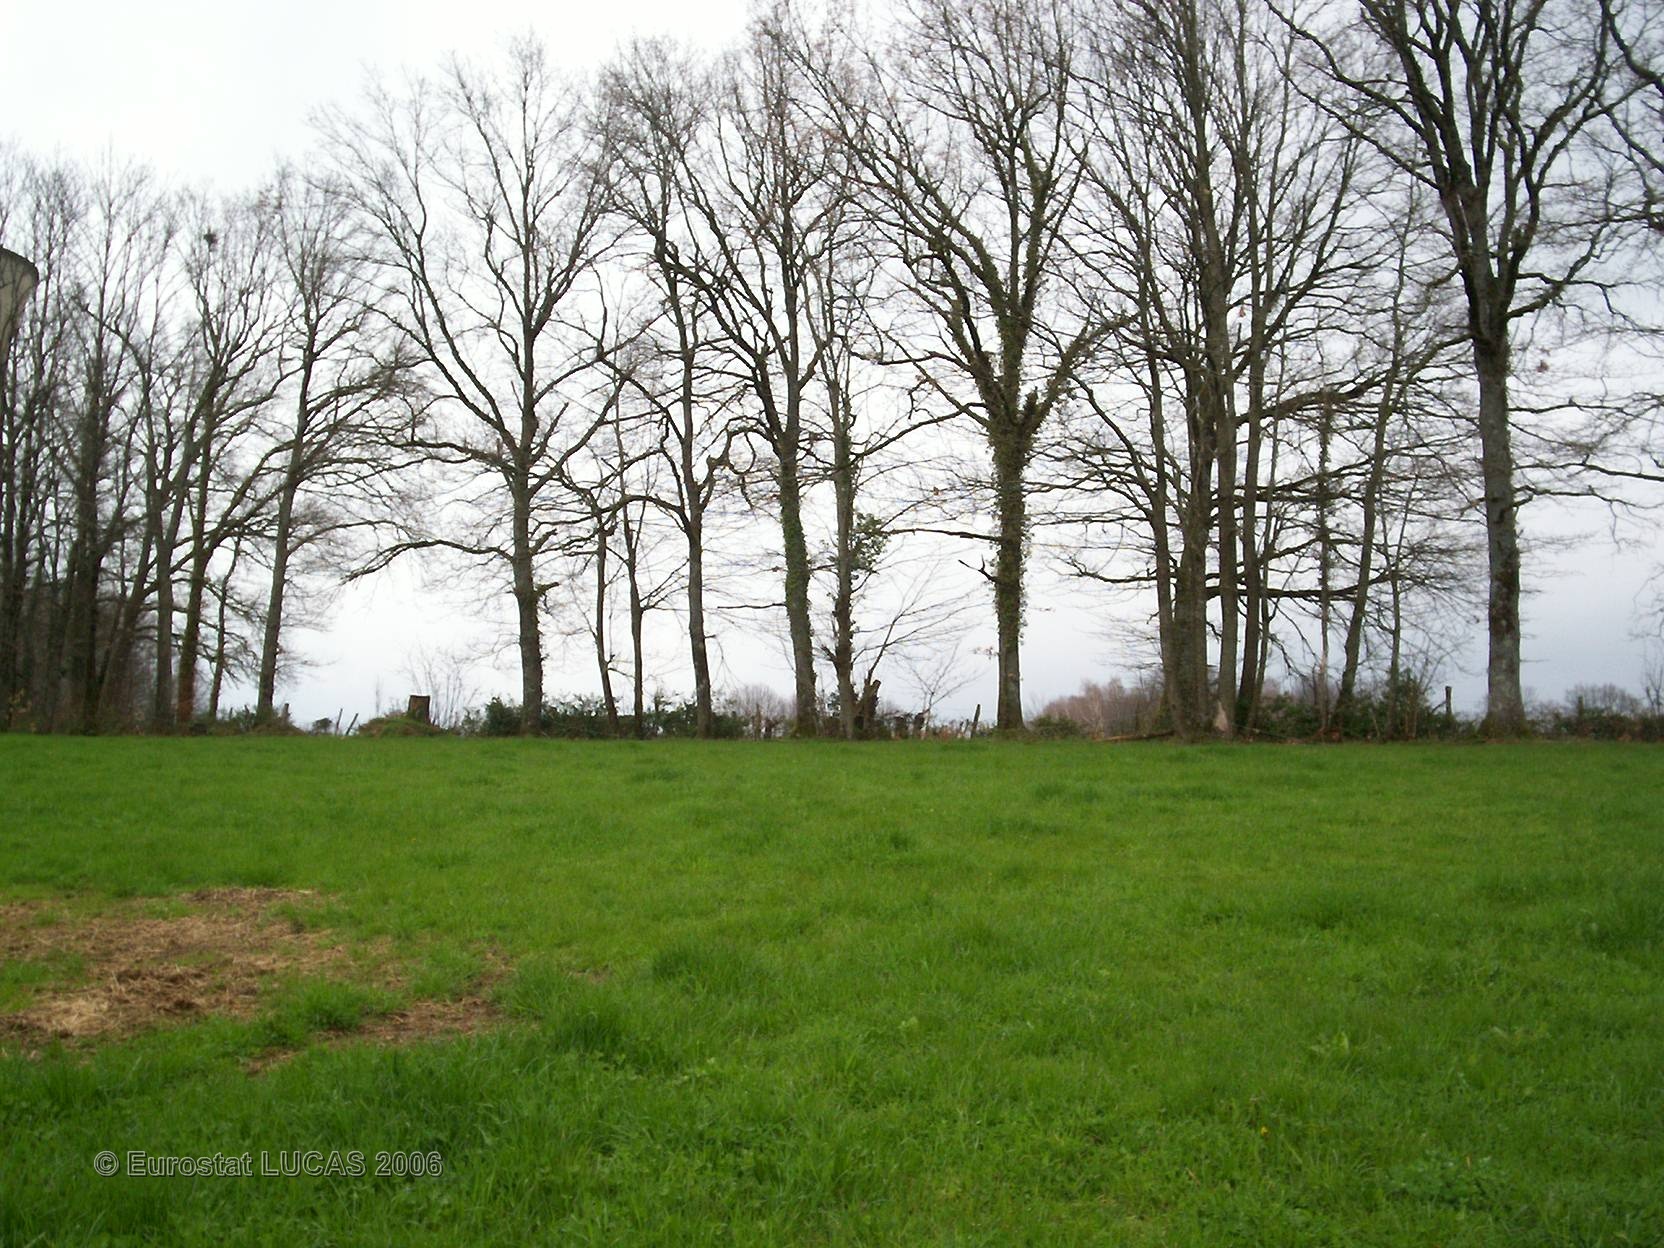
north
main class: Grassland
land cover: Grassland without tree/shrub cover
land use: Agriculture (excluding fallow land and kitchen gardens)
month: April
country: FR
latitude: 45.4962
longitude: 1.6124
